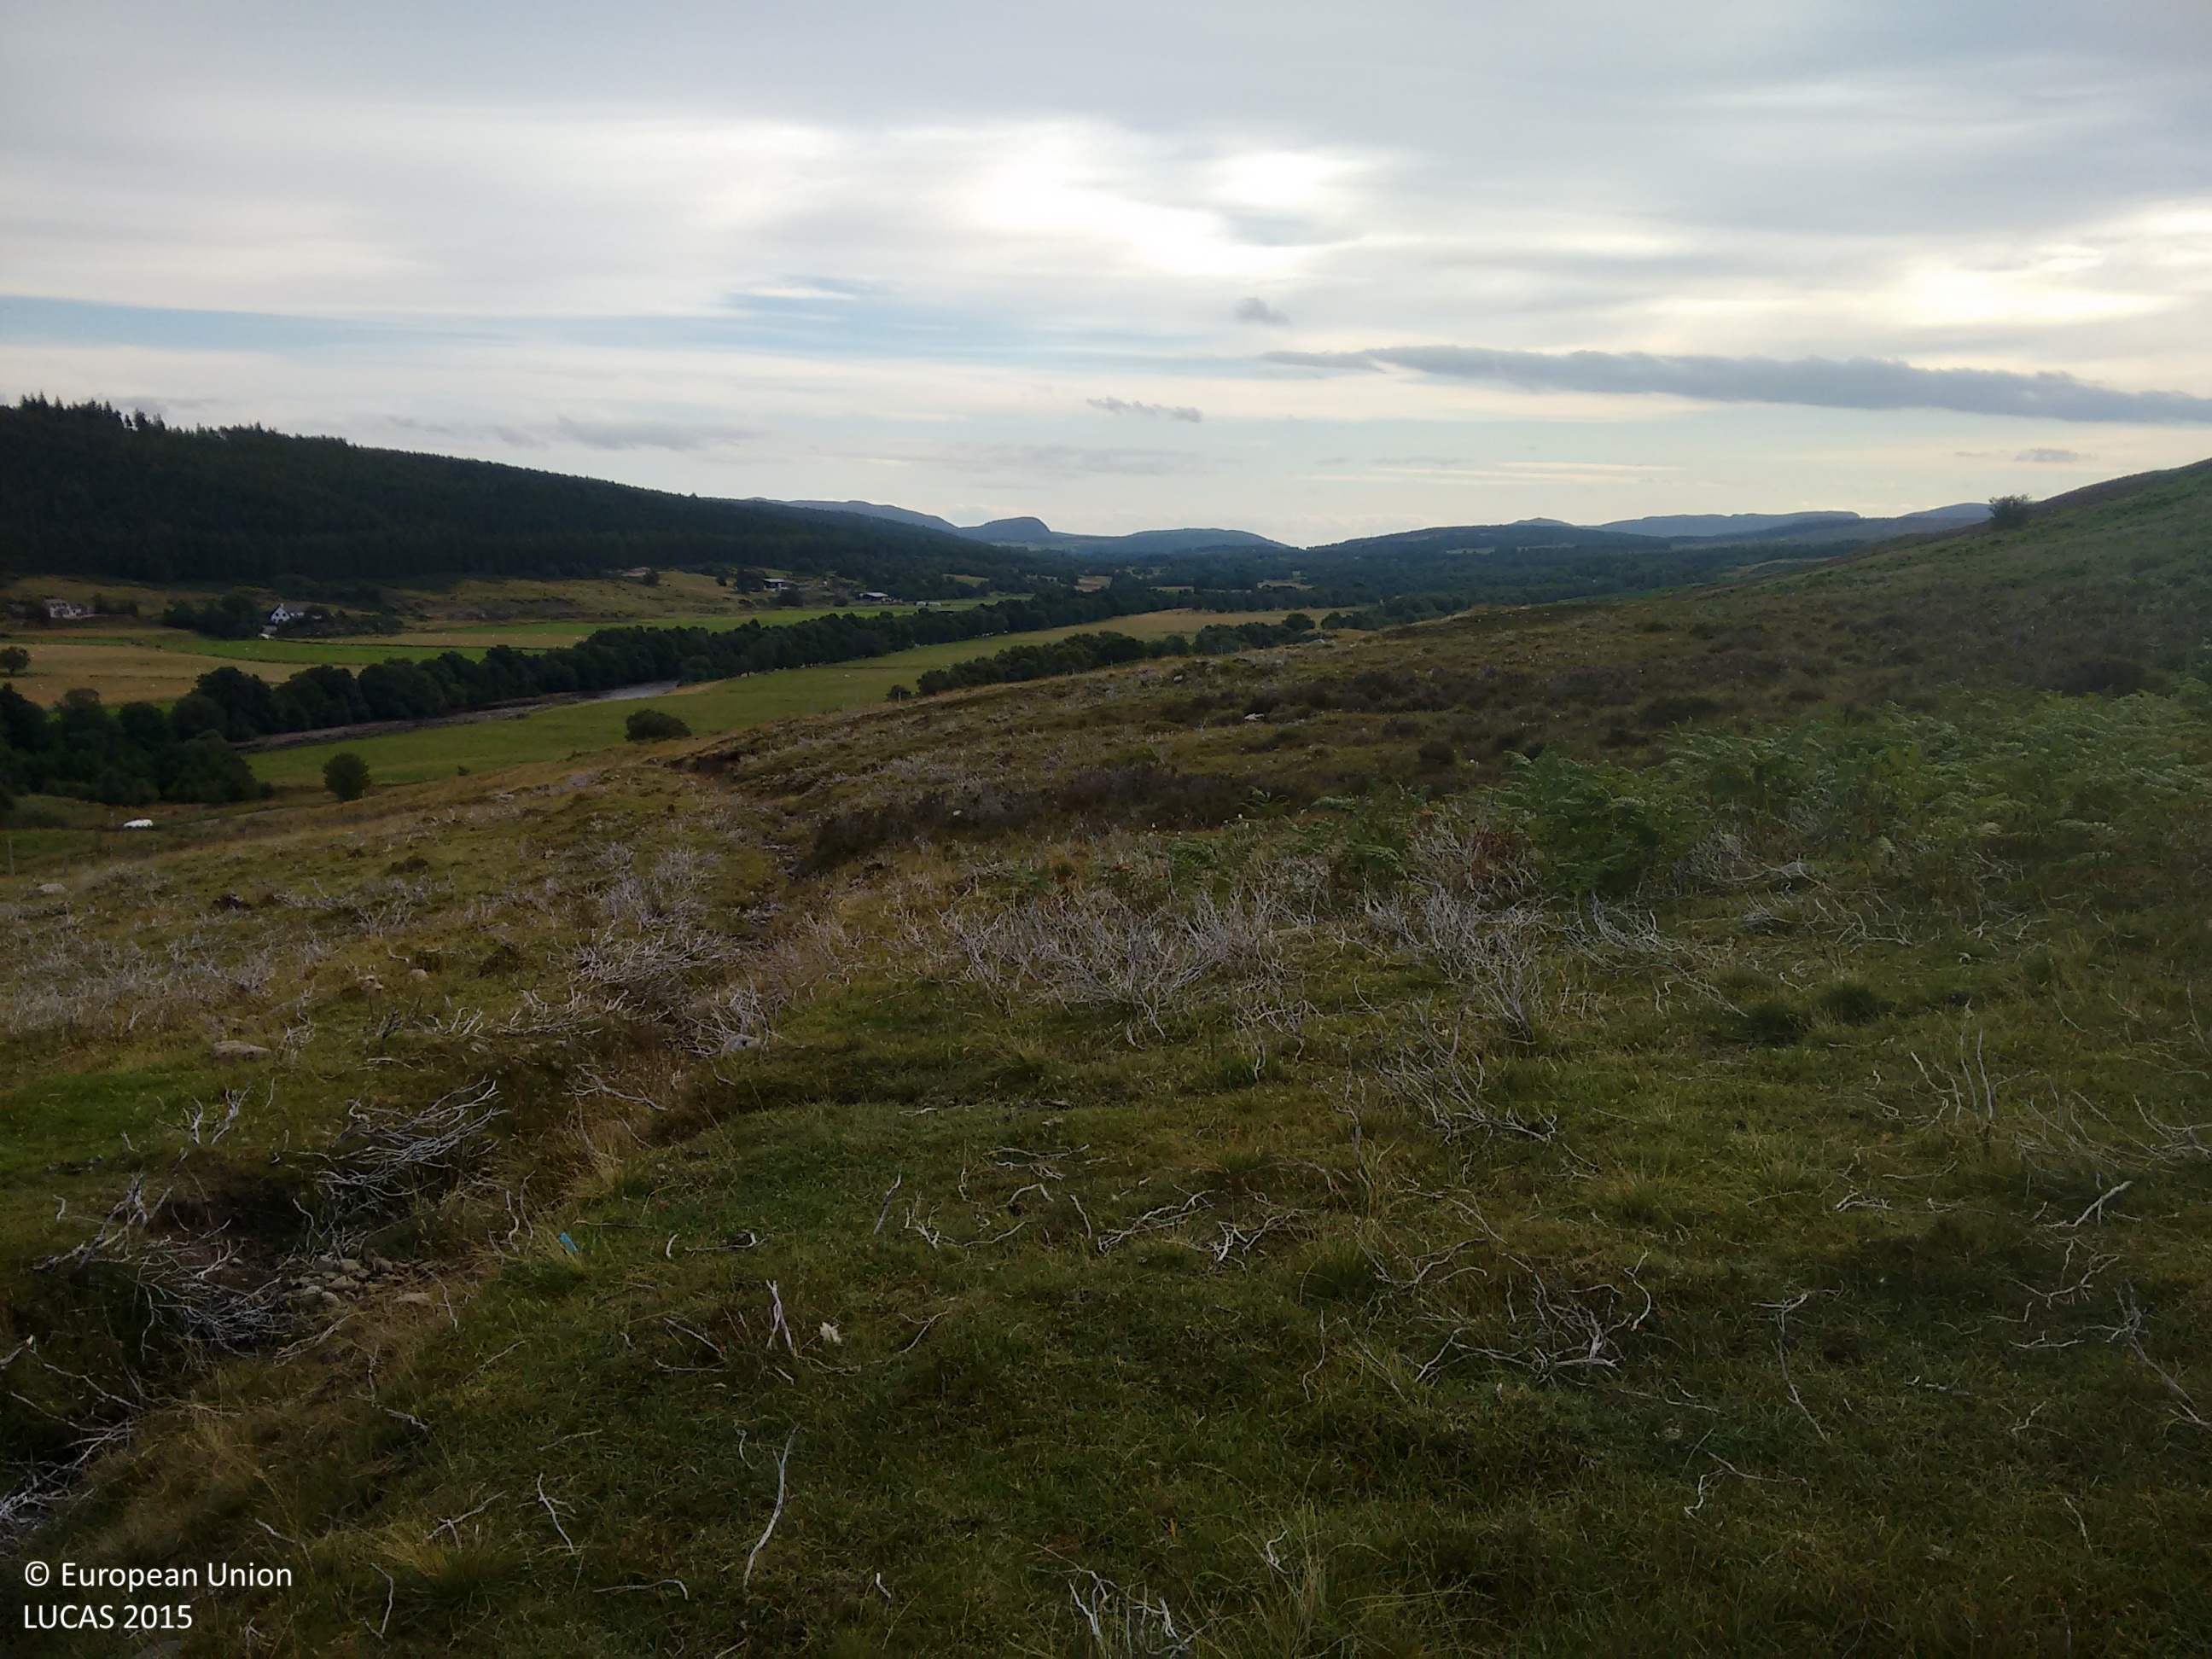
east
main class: Grassland
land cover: Grassland without tree/shrub cover
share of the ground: > 75 %
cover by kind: herbaceous plants 95 %, shrubs 5 %
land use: Agriculture (excluding fallow land and kitchen gardens)
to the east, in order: Grassland without tree/shrub cover; Tracks; Shrubland without tree cover; Fences; Grassland without tree/shrub cover; Ditches and canals; Grassland without tree/shrub cover
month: September
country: GB
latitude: 57.8879
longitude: -4.4755
